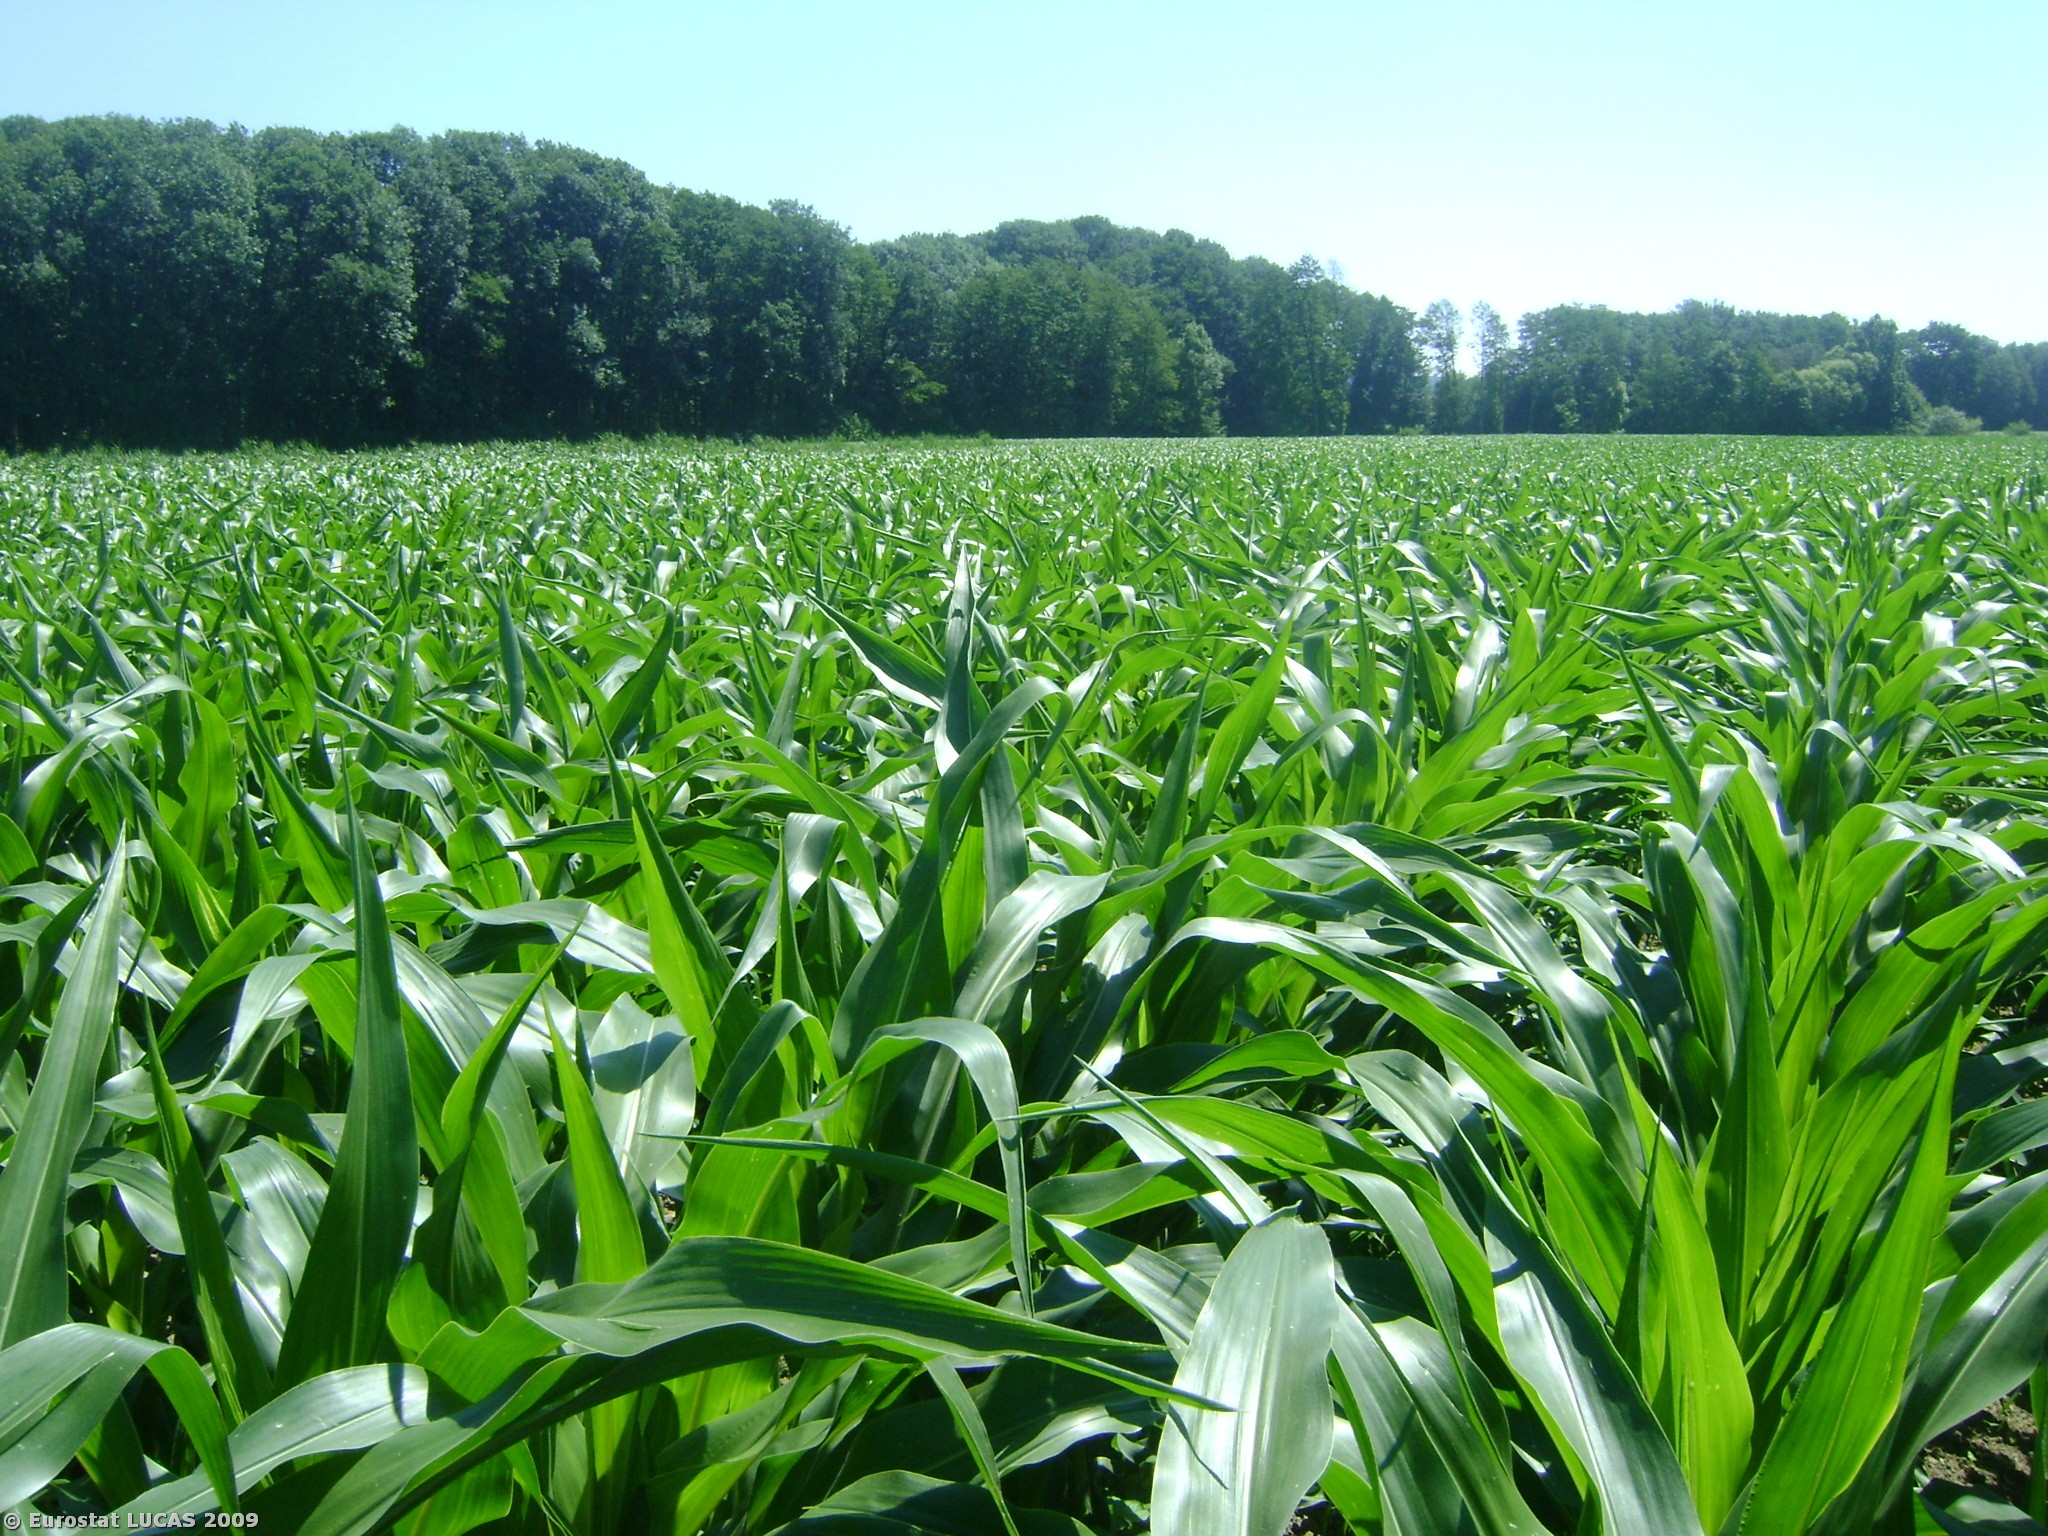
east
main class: Cropland
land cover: Maize
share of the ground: 50 - 75 %
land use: Agriculture (excluding fallow land and kitchen gardens)
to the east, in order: Maize; Ditches and canals; Broadleaved woodland
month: June
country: AT
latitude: 46.8750
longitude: 15.5497
